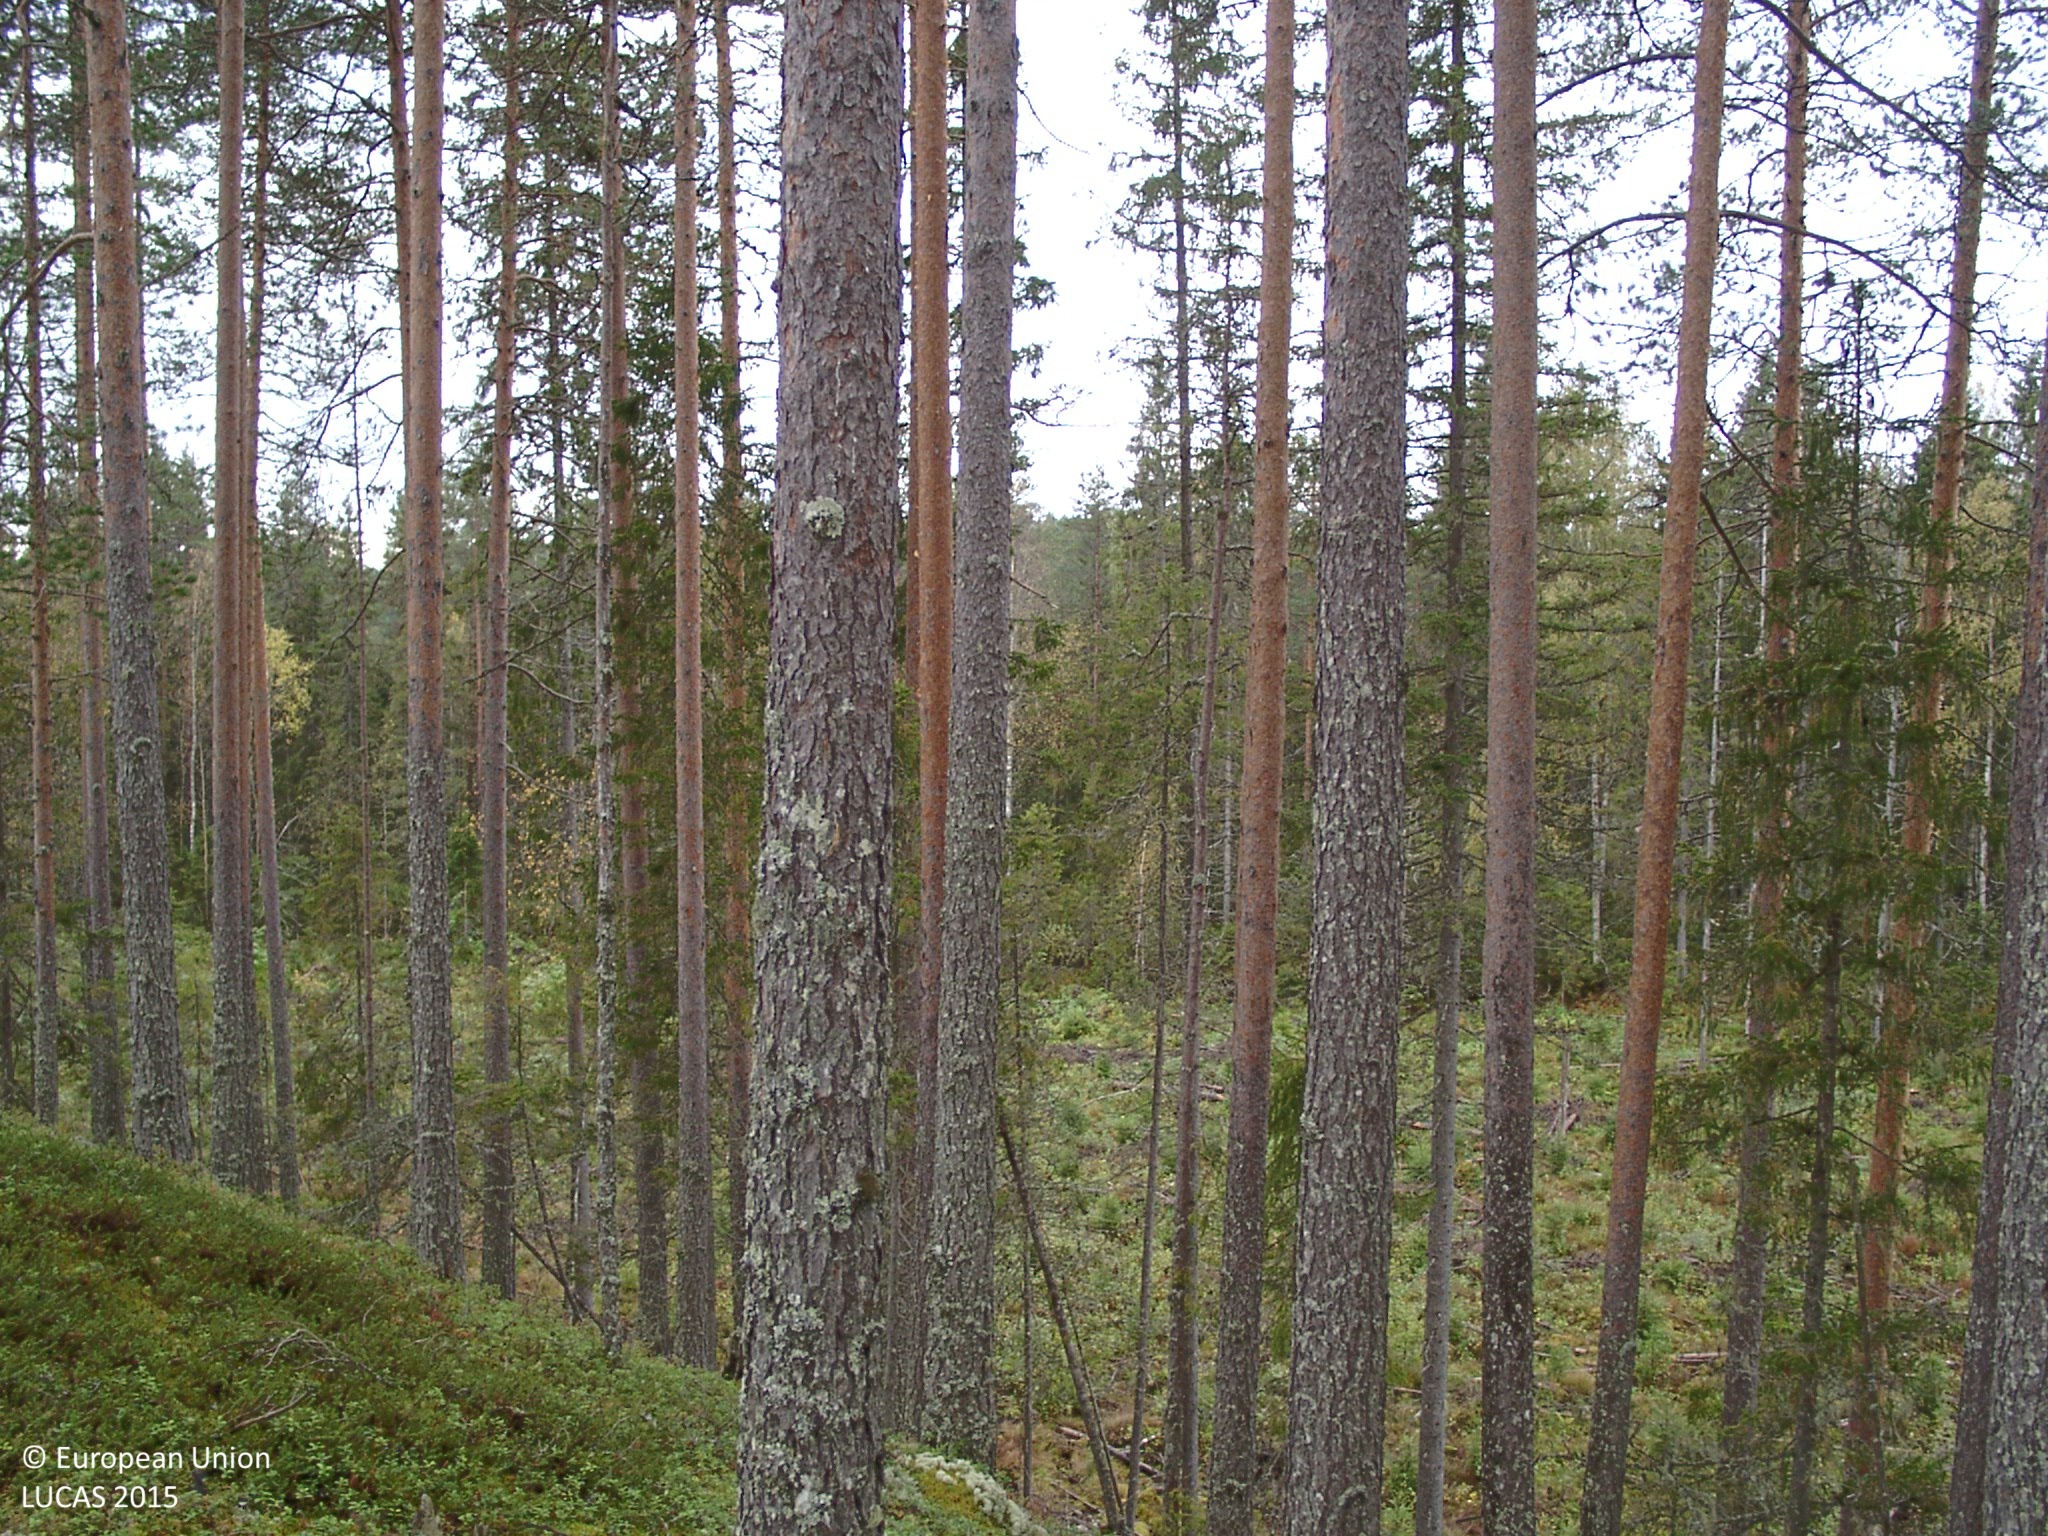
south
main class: Woodland
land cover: Pine dominated coniferous woodland
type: boreal forest
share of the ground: 50 - 75 %
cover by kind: coniferous forest trees 60 %, lichens and mosses 25 %, shrubs 15 %
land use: Forestry
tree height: > 5 m
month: September
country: FI
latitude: 62.7791
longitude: 25.3310
